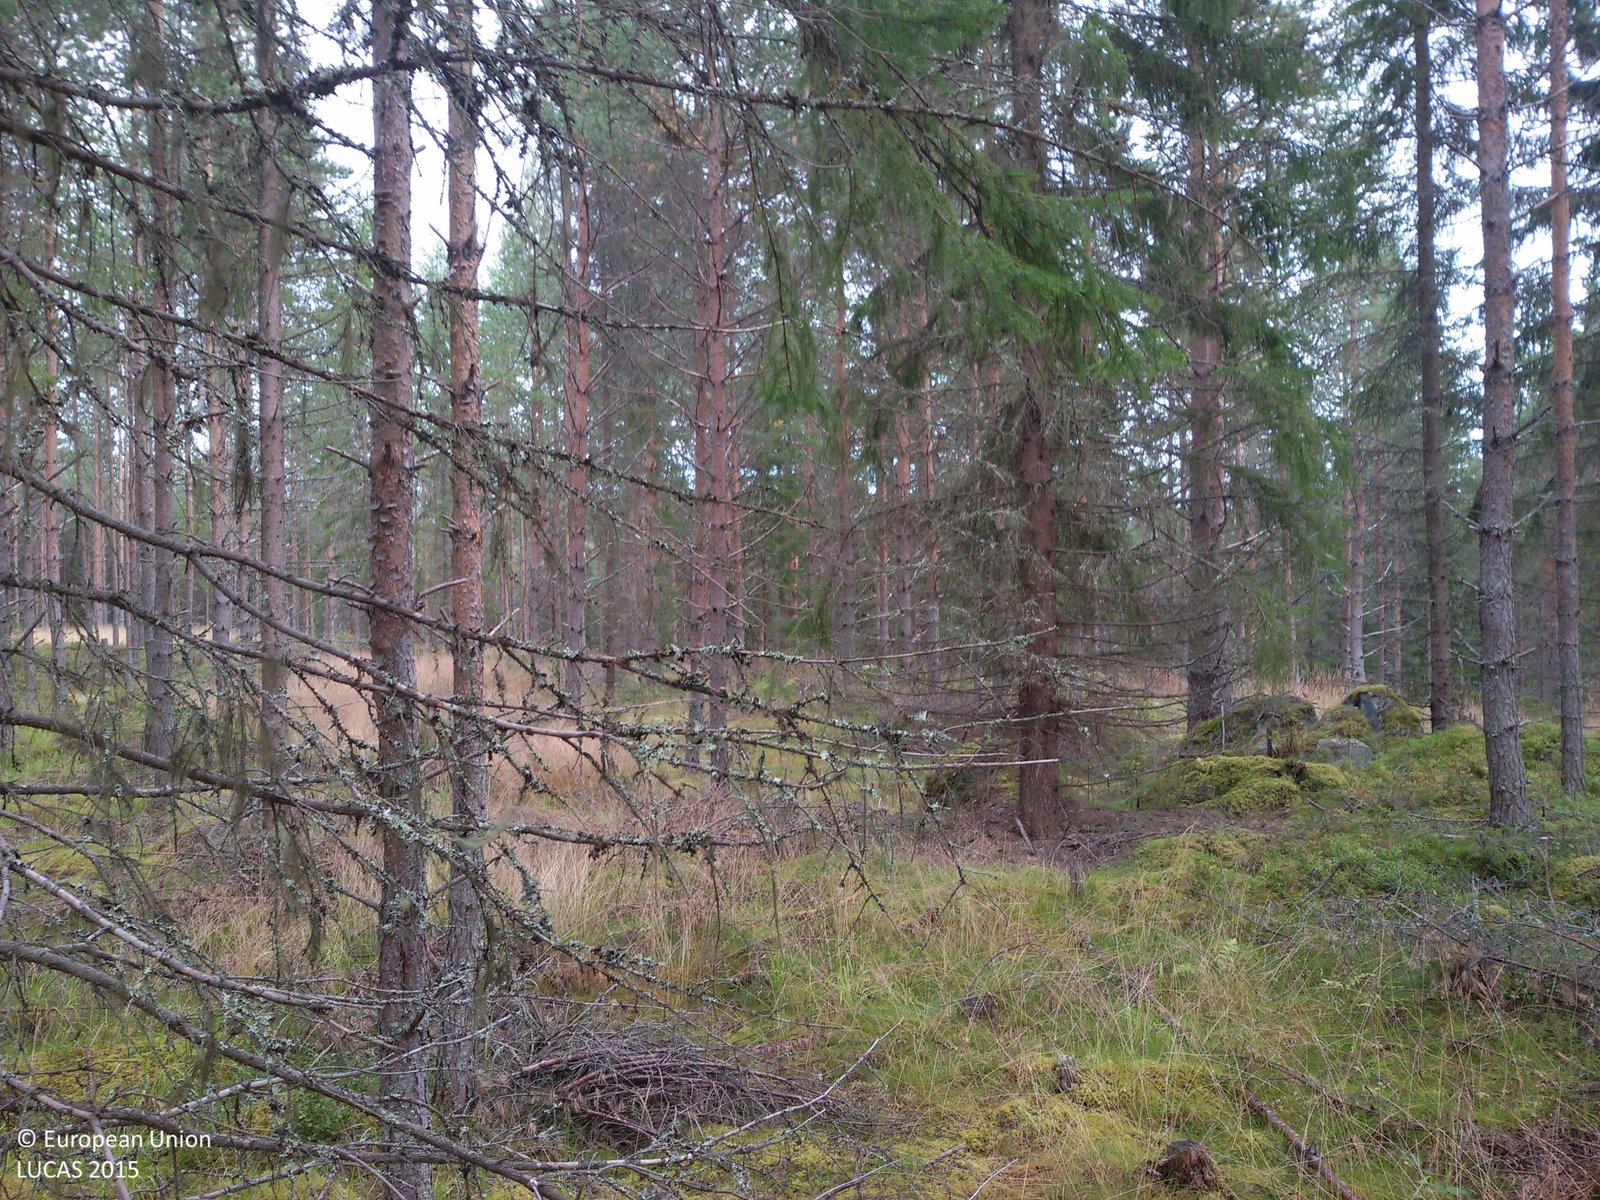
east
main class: Woodland
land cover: Pine dominated coniferous woodland
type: boreal forest
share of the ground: 50 - 75 %
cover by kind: coniferous forest trees 70 %, lichens and mosses 20 %, herbaceous plants 10 %
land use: Forestry
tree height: > 5 m
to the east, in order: Pine dominated coniferous woodland; Spontaneously vegetated surfaces; Pine dominated coniferous woodland
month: September
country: SE
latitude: 60.6928
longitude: 15.3531
